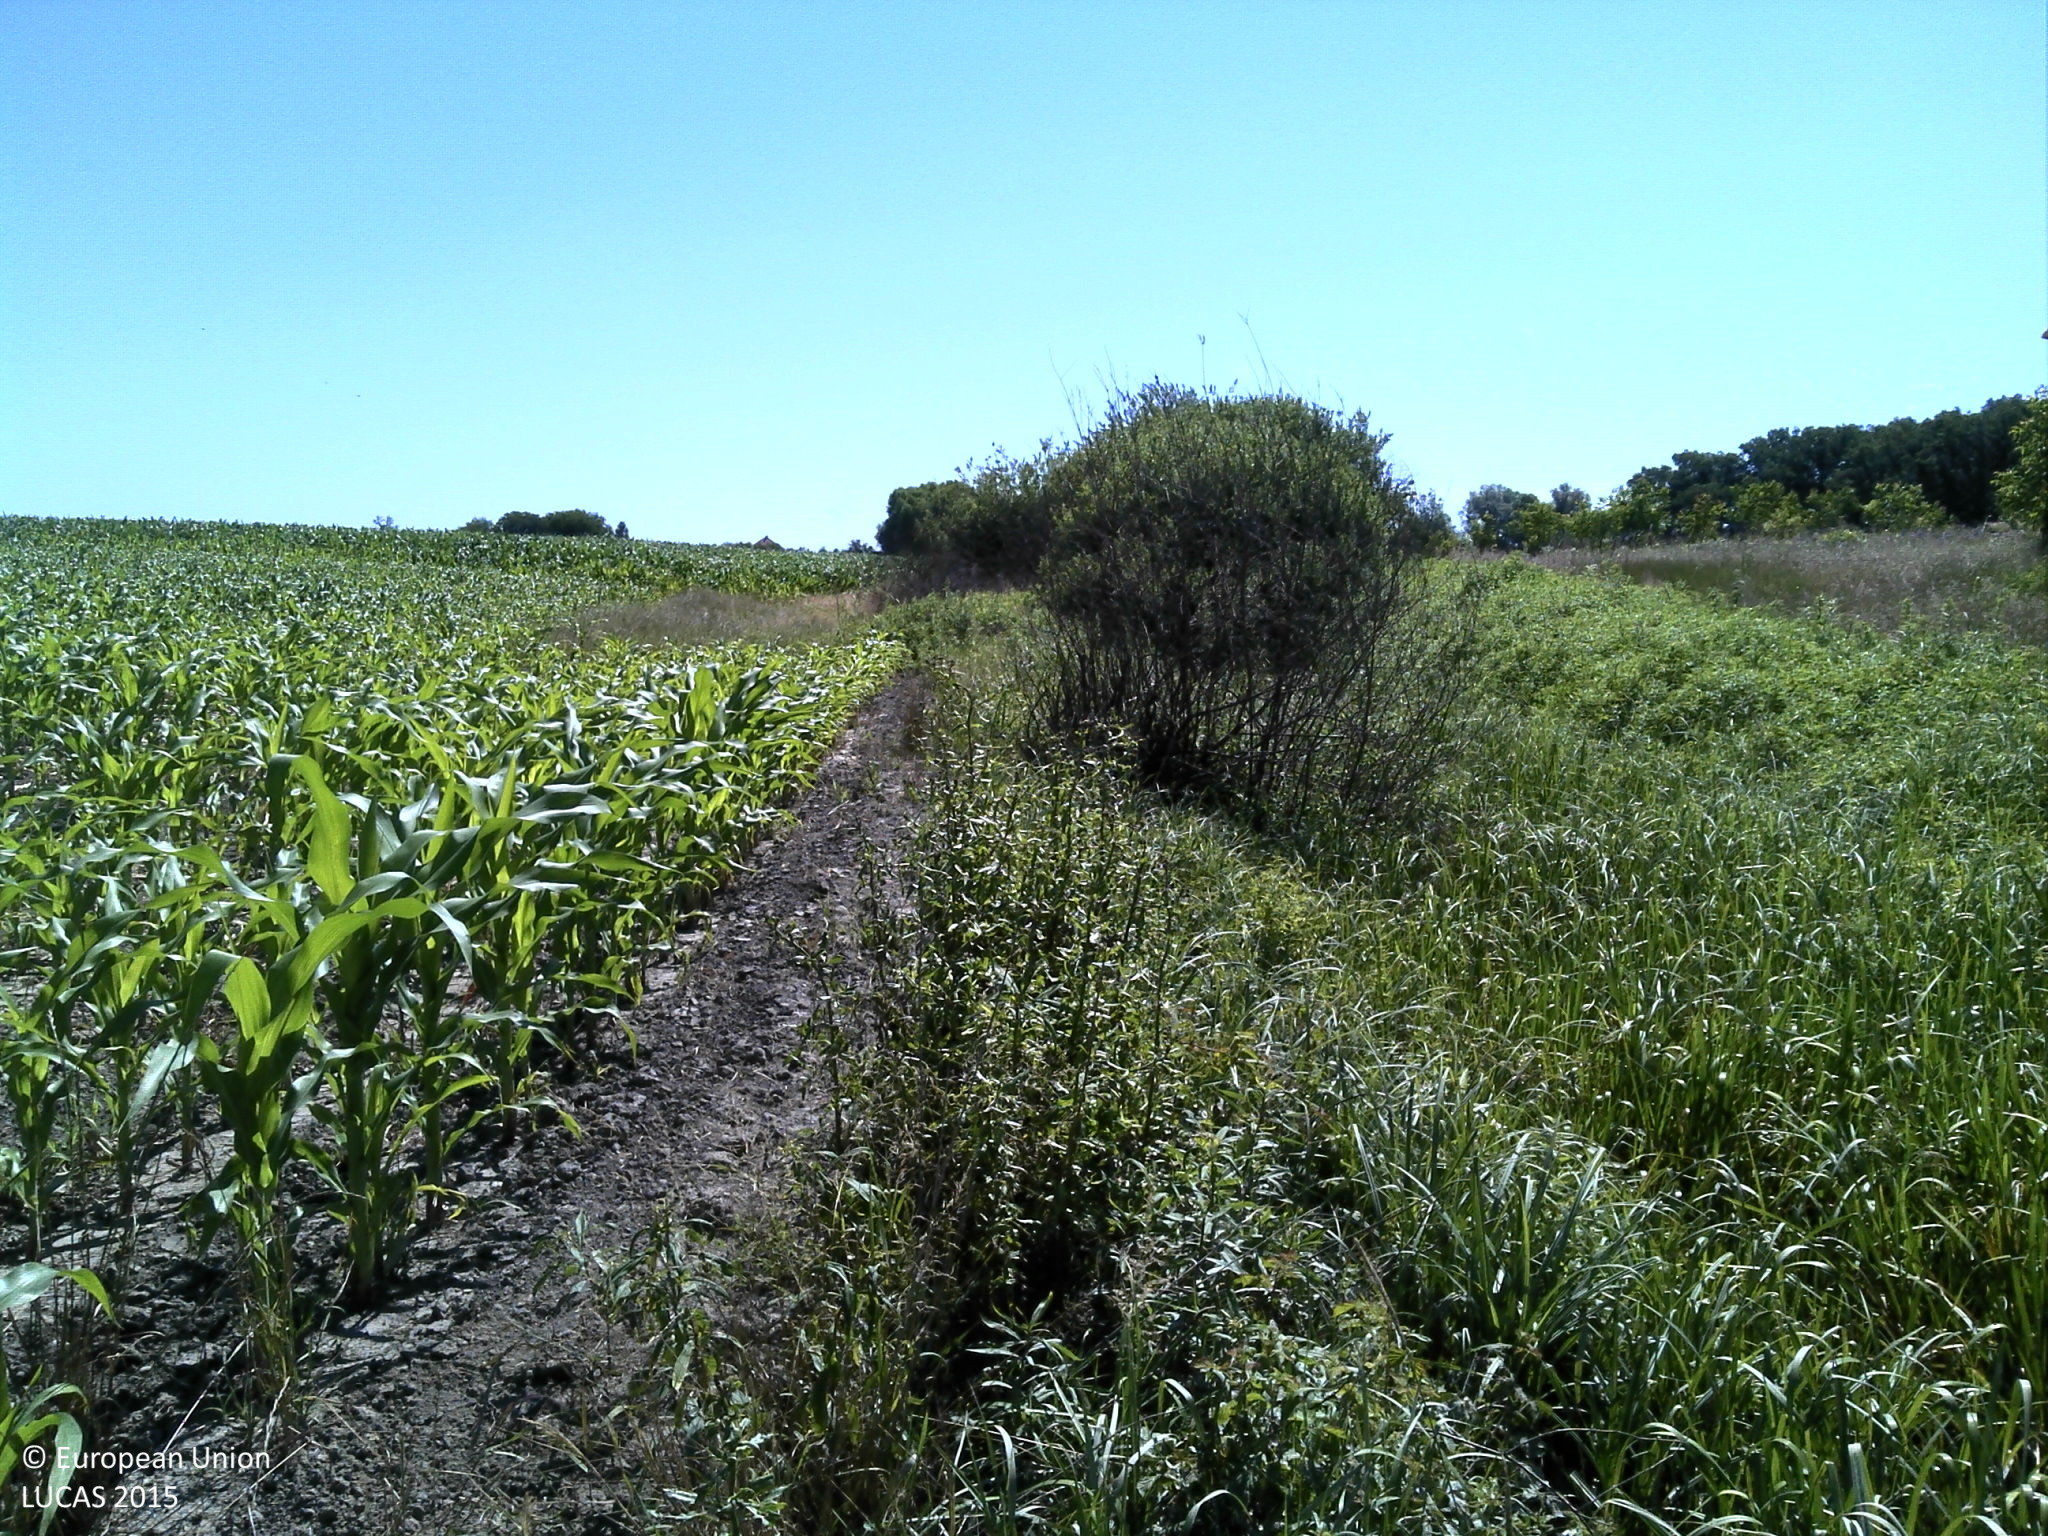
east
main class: Grassland
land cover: Grassland without tree/shrub cover
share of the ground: > 75 %
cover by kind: herbaceous plants 100 %
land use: Semi-natural and natural areas not in use
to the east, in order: Grassland without tree/shrub cover; Ditches and canals; Shrubland with sparse tree cover; Tracks; Ditches and canals; Common wheat
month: June
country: HR
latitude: 45.7465
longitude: 17.9610
